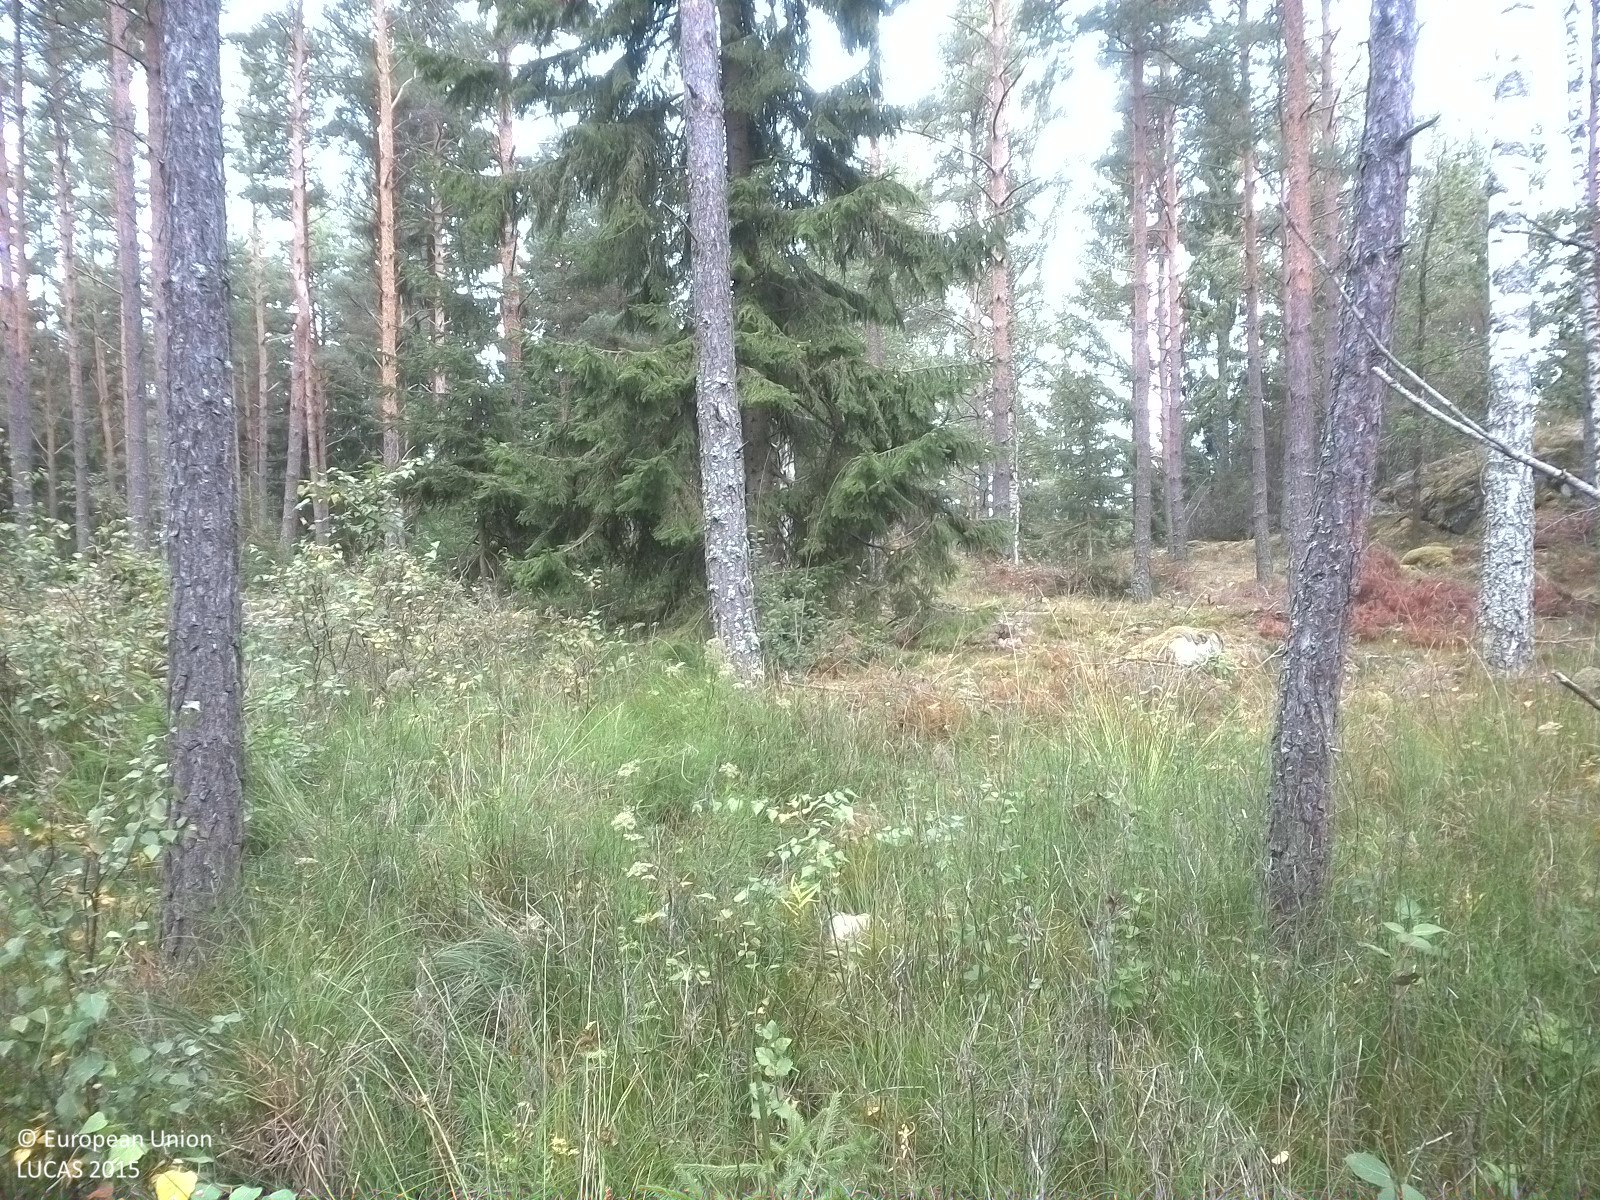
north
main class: Woodland
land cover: Pine dominated mixed woodland
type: boreal forest
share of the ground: 25 - 50 %
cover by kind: herbaceous plants 35 %, lichens and mosses 25 %, coniferous forest trees 20 %, broadleaved forest trees 15 %, shrubs 5 %
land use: Semi-natural and natural areas not in use
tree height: > 5 m
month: September
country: SE
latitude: 58.5347
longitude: 16.4369
